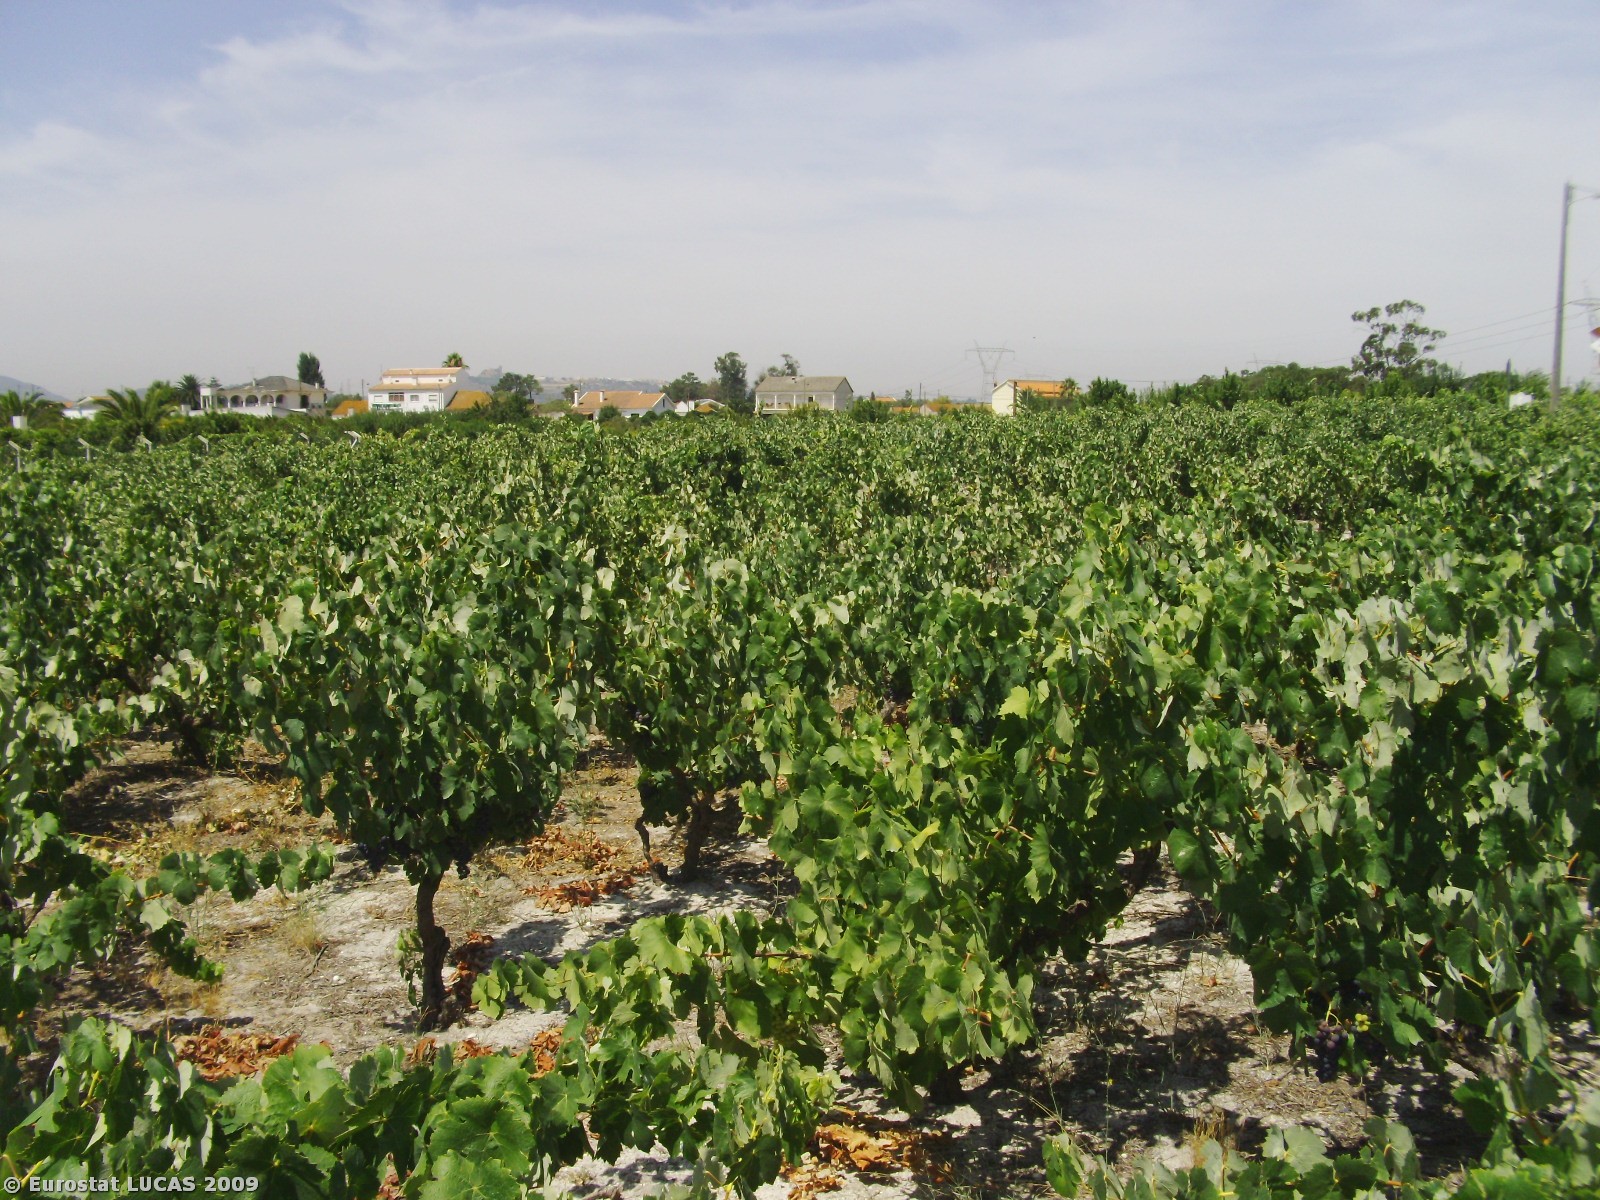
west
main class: Cropland
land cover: Vineyards
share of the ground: 25 - 50 %
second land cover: Spontaneously vegetated surfaces
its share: 50 - 75 %
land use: Agriculture (excluding fallow land and kitchen gardens)
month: July
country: PT
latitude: 38.5735
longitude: -8.8301
